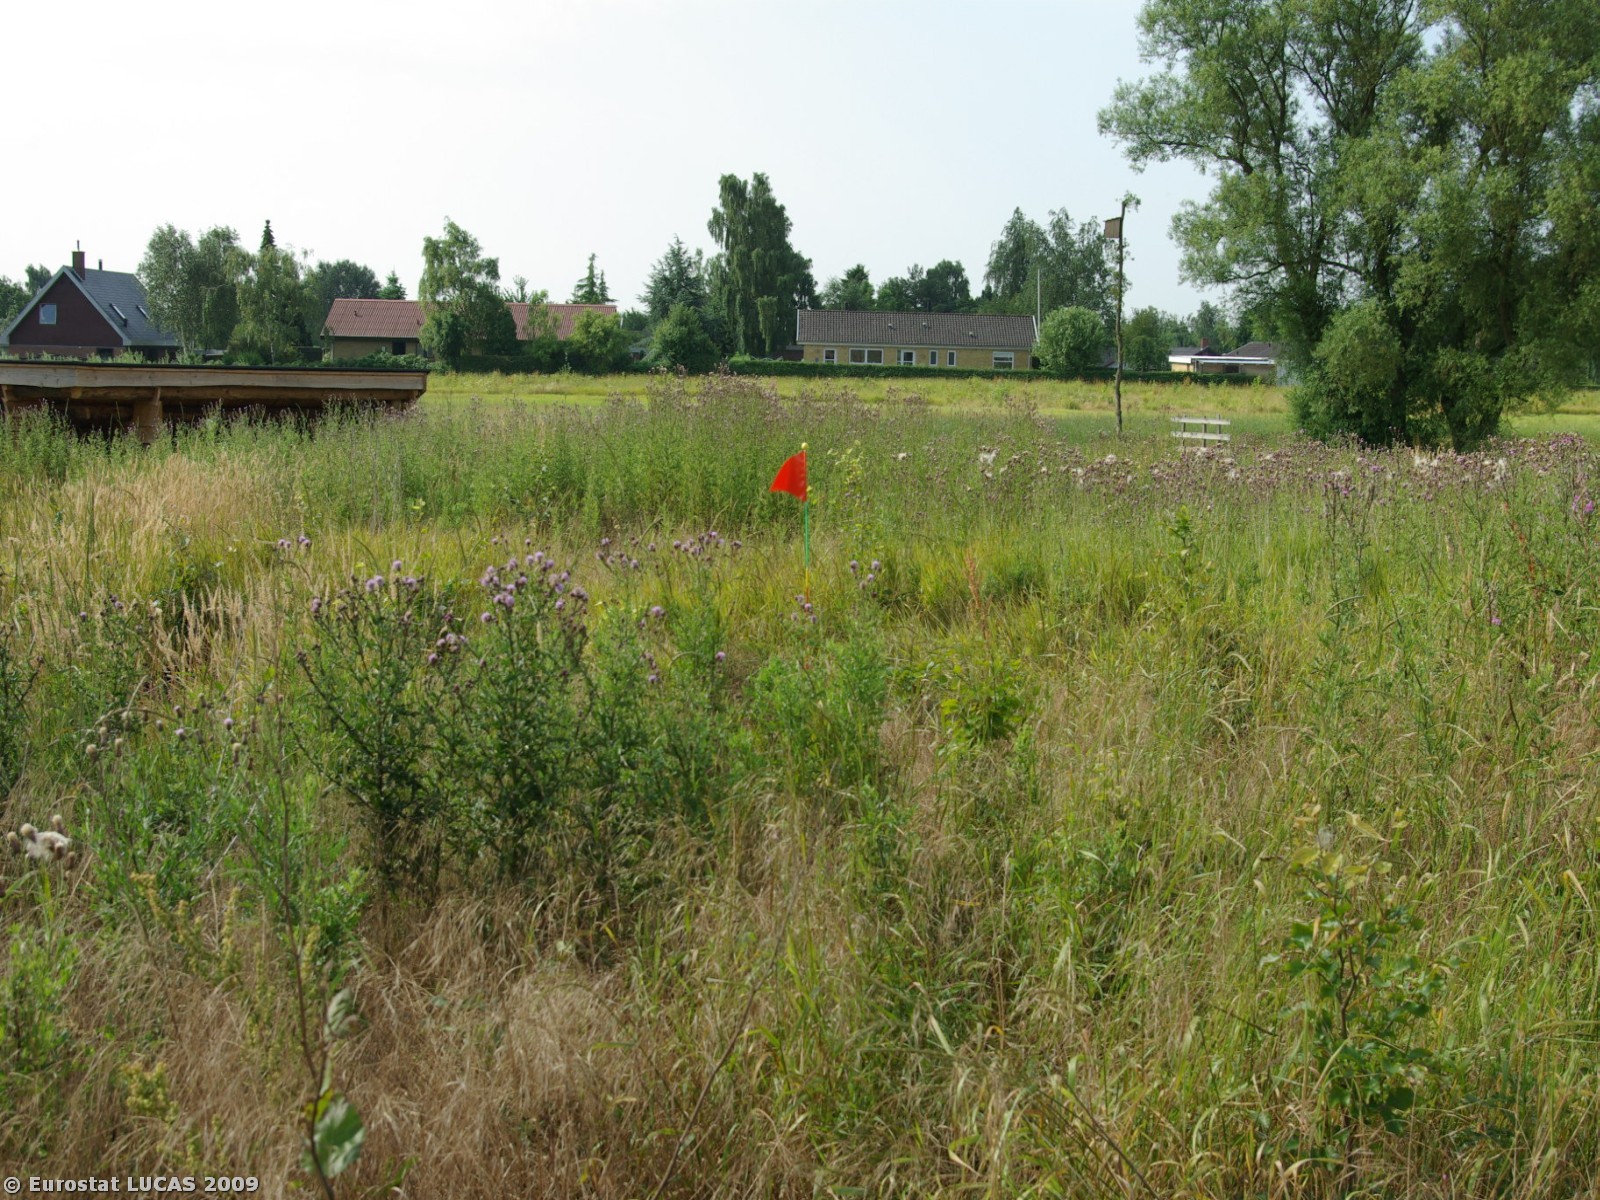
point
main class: Woodland
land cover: Broadleaved woodland
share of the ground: < 10 %
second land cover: Spontaneously vegetated surfaces
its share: > 75 %
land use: Amenities, museums, leisure
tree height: < 5 m
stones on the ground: < 10 %
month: July
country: DK
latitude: 54.9291
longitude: 9.6725
